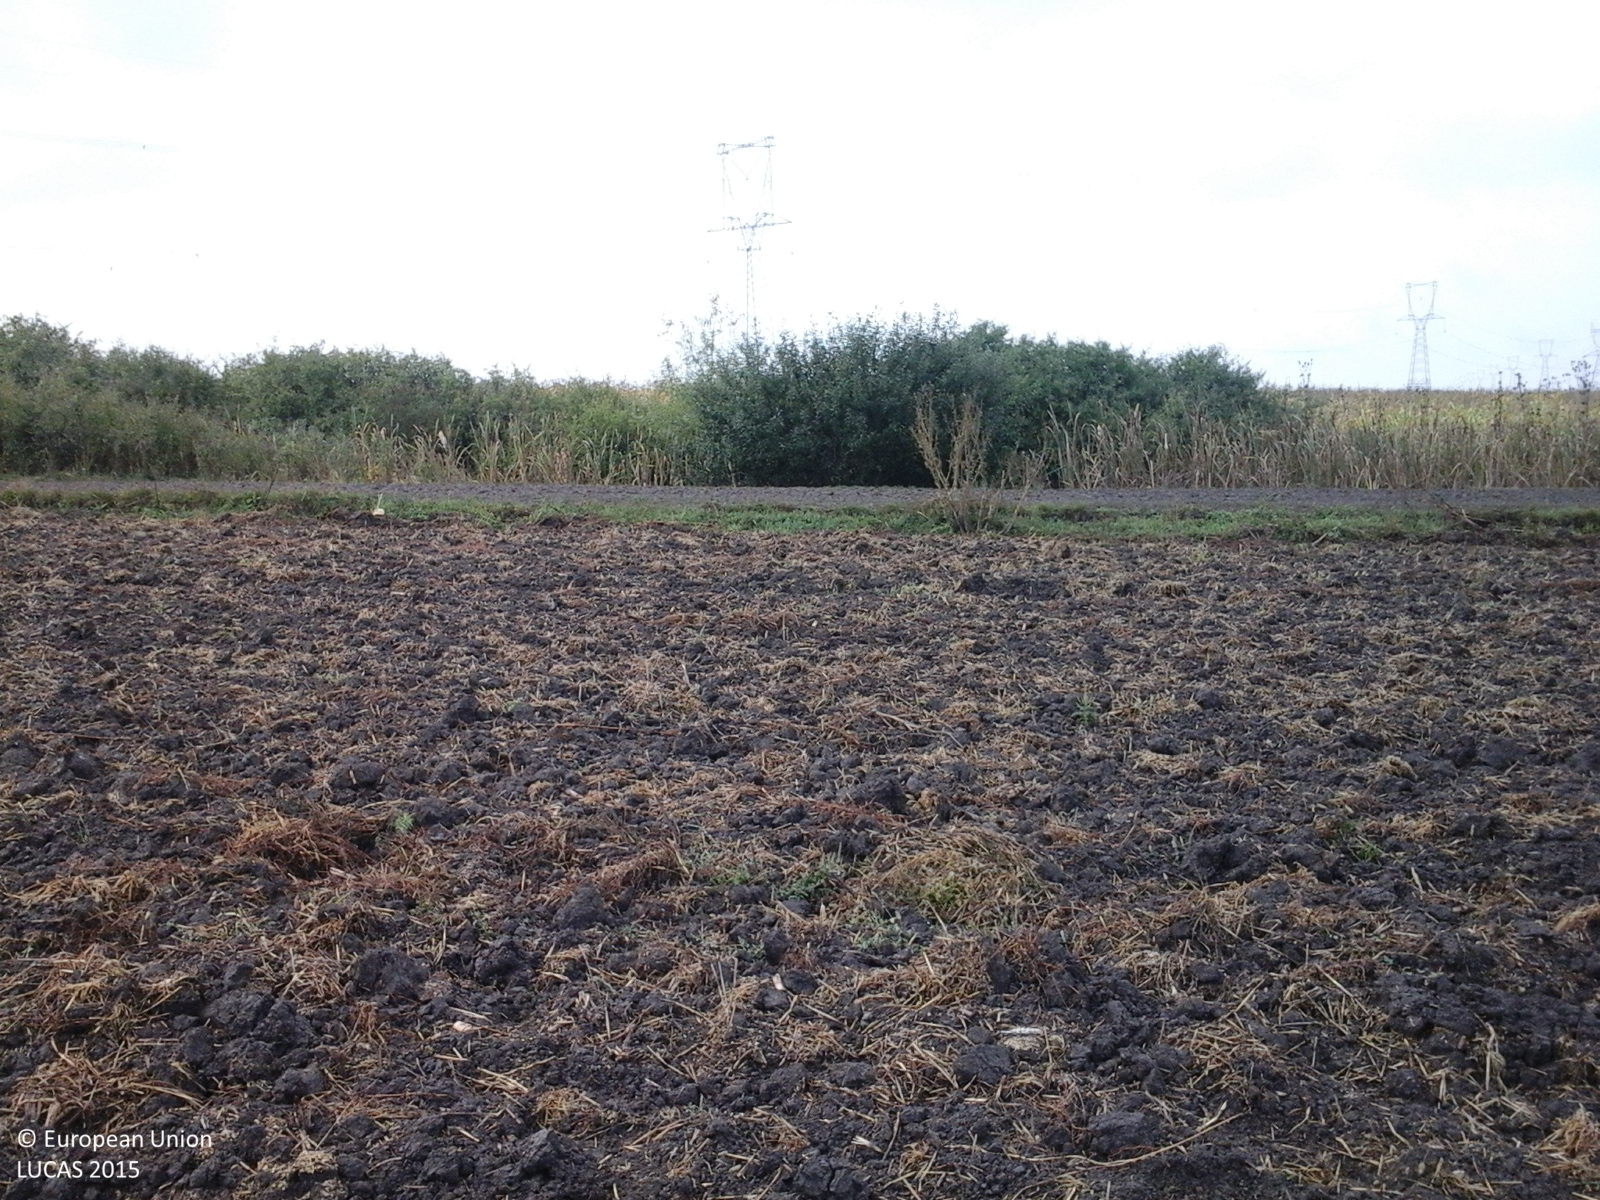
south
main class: Cropland
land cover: Common wheat
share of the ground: < 10 %
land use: Agriculture (excluding fallow land and kitchen gardens)
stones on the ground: < 10 %
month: September
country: RO
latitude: 46.8318
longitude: 21.7235
